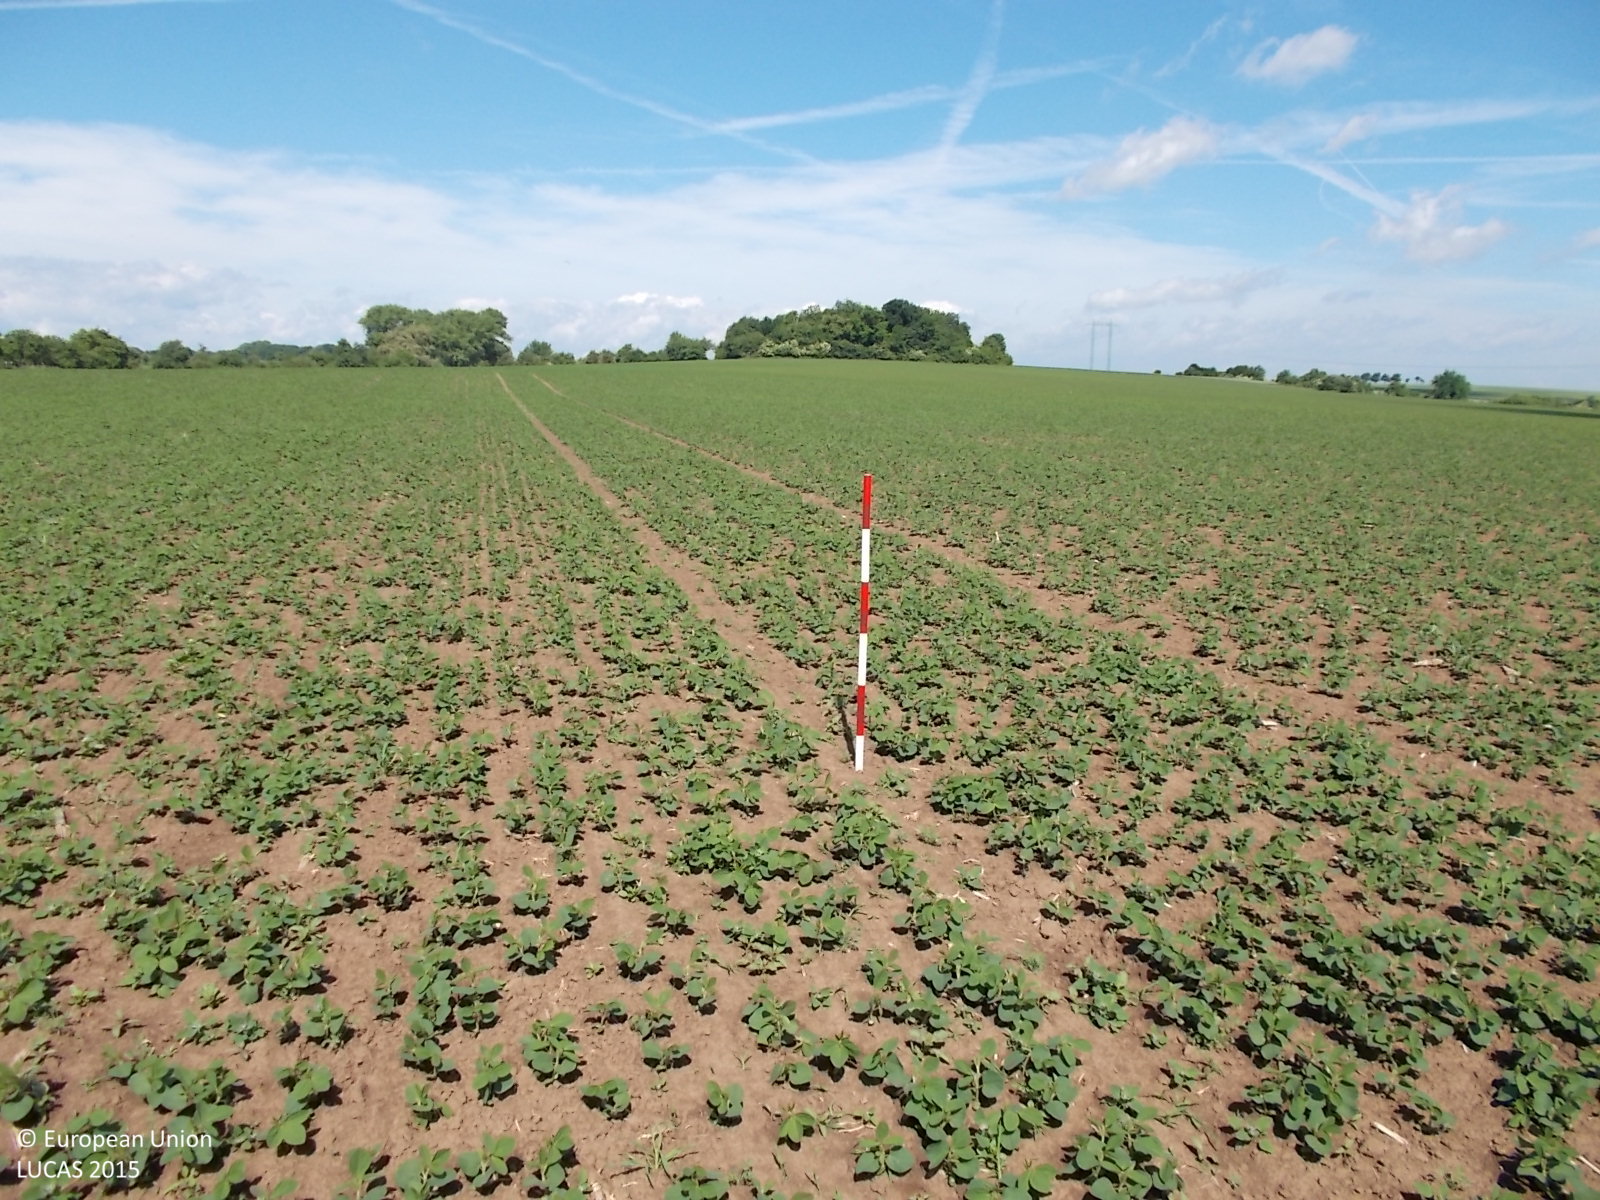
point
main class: Cropland
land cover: Soya
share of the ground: 25 - 50 %
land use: Agriculture (excluding fallow land and kitchen gardens)
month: June
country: CZ
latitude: 50.0137
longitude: 15.1525
